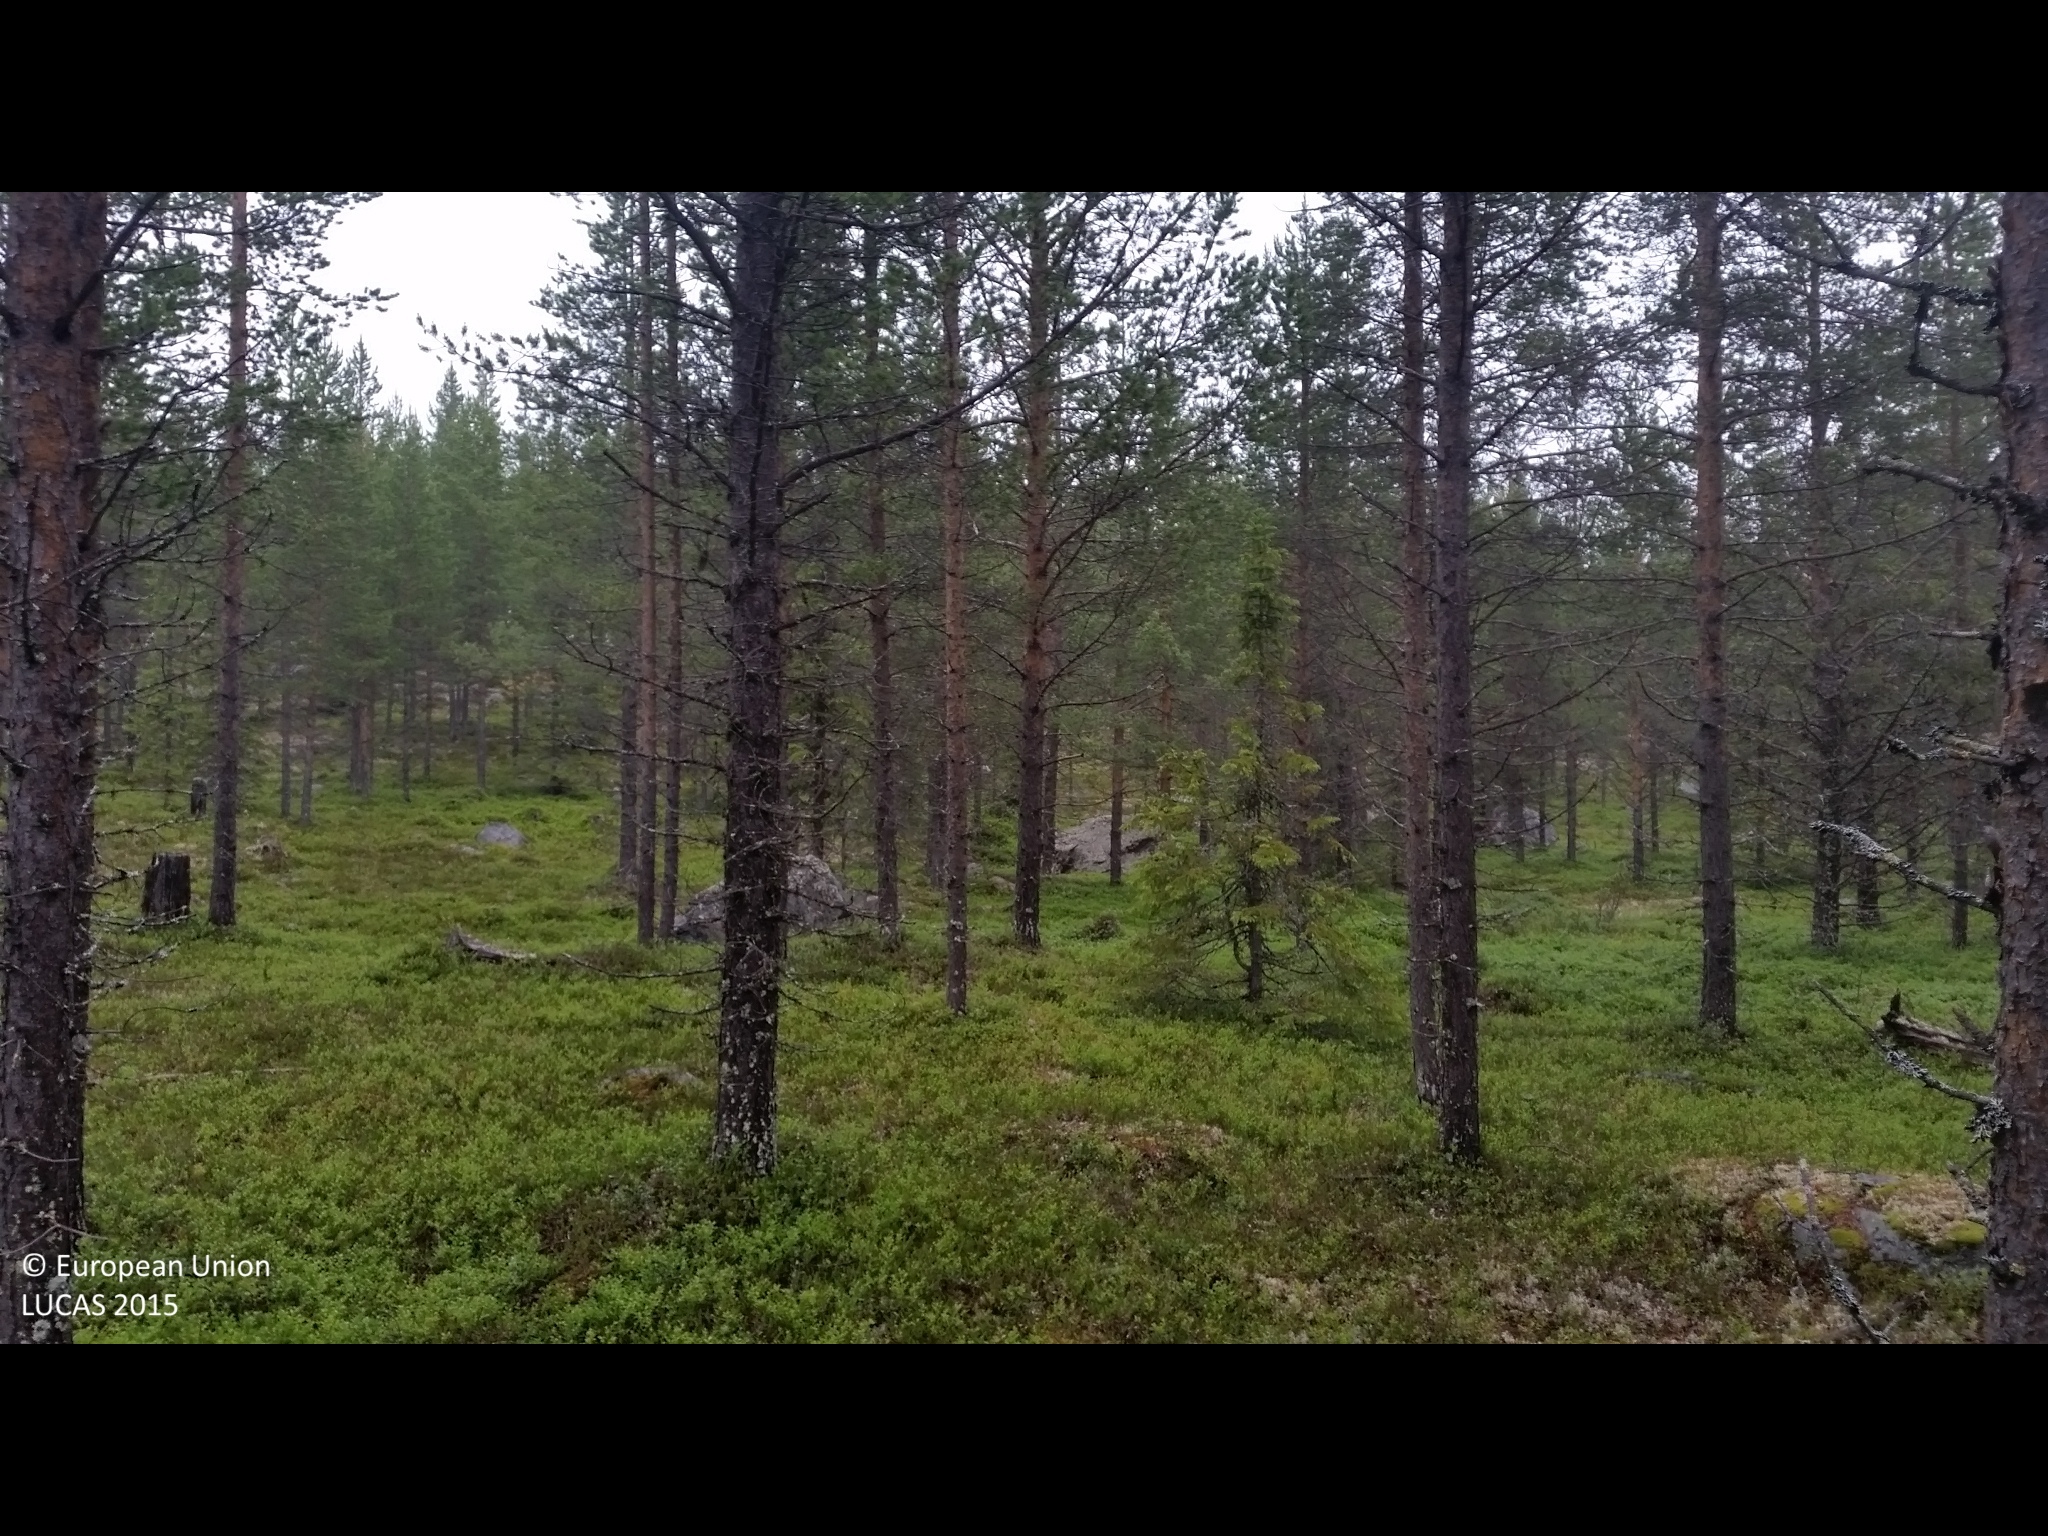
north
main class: Woodland
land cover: Pine dominated coniferous woodland
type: boreal forest
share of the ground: 50 - 75 %
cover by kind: coniferous forest trees 65 %, shrubs 25 %, lichens and mosses 5 %, consolidated bare surface 5 %
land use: Forestry
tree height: > 5 m
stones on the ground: > 50 %
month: July
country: SE
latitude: 65.8823
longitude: 18.0934
